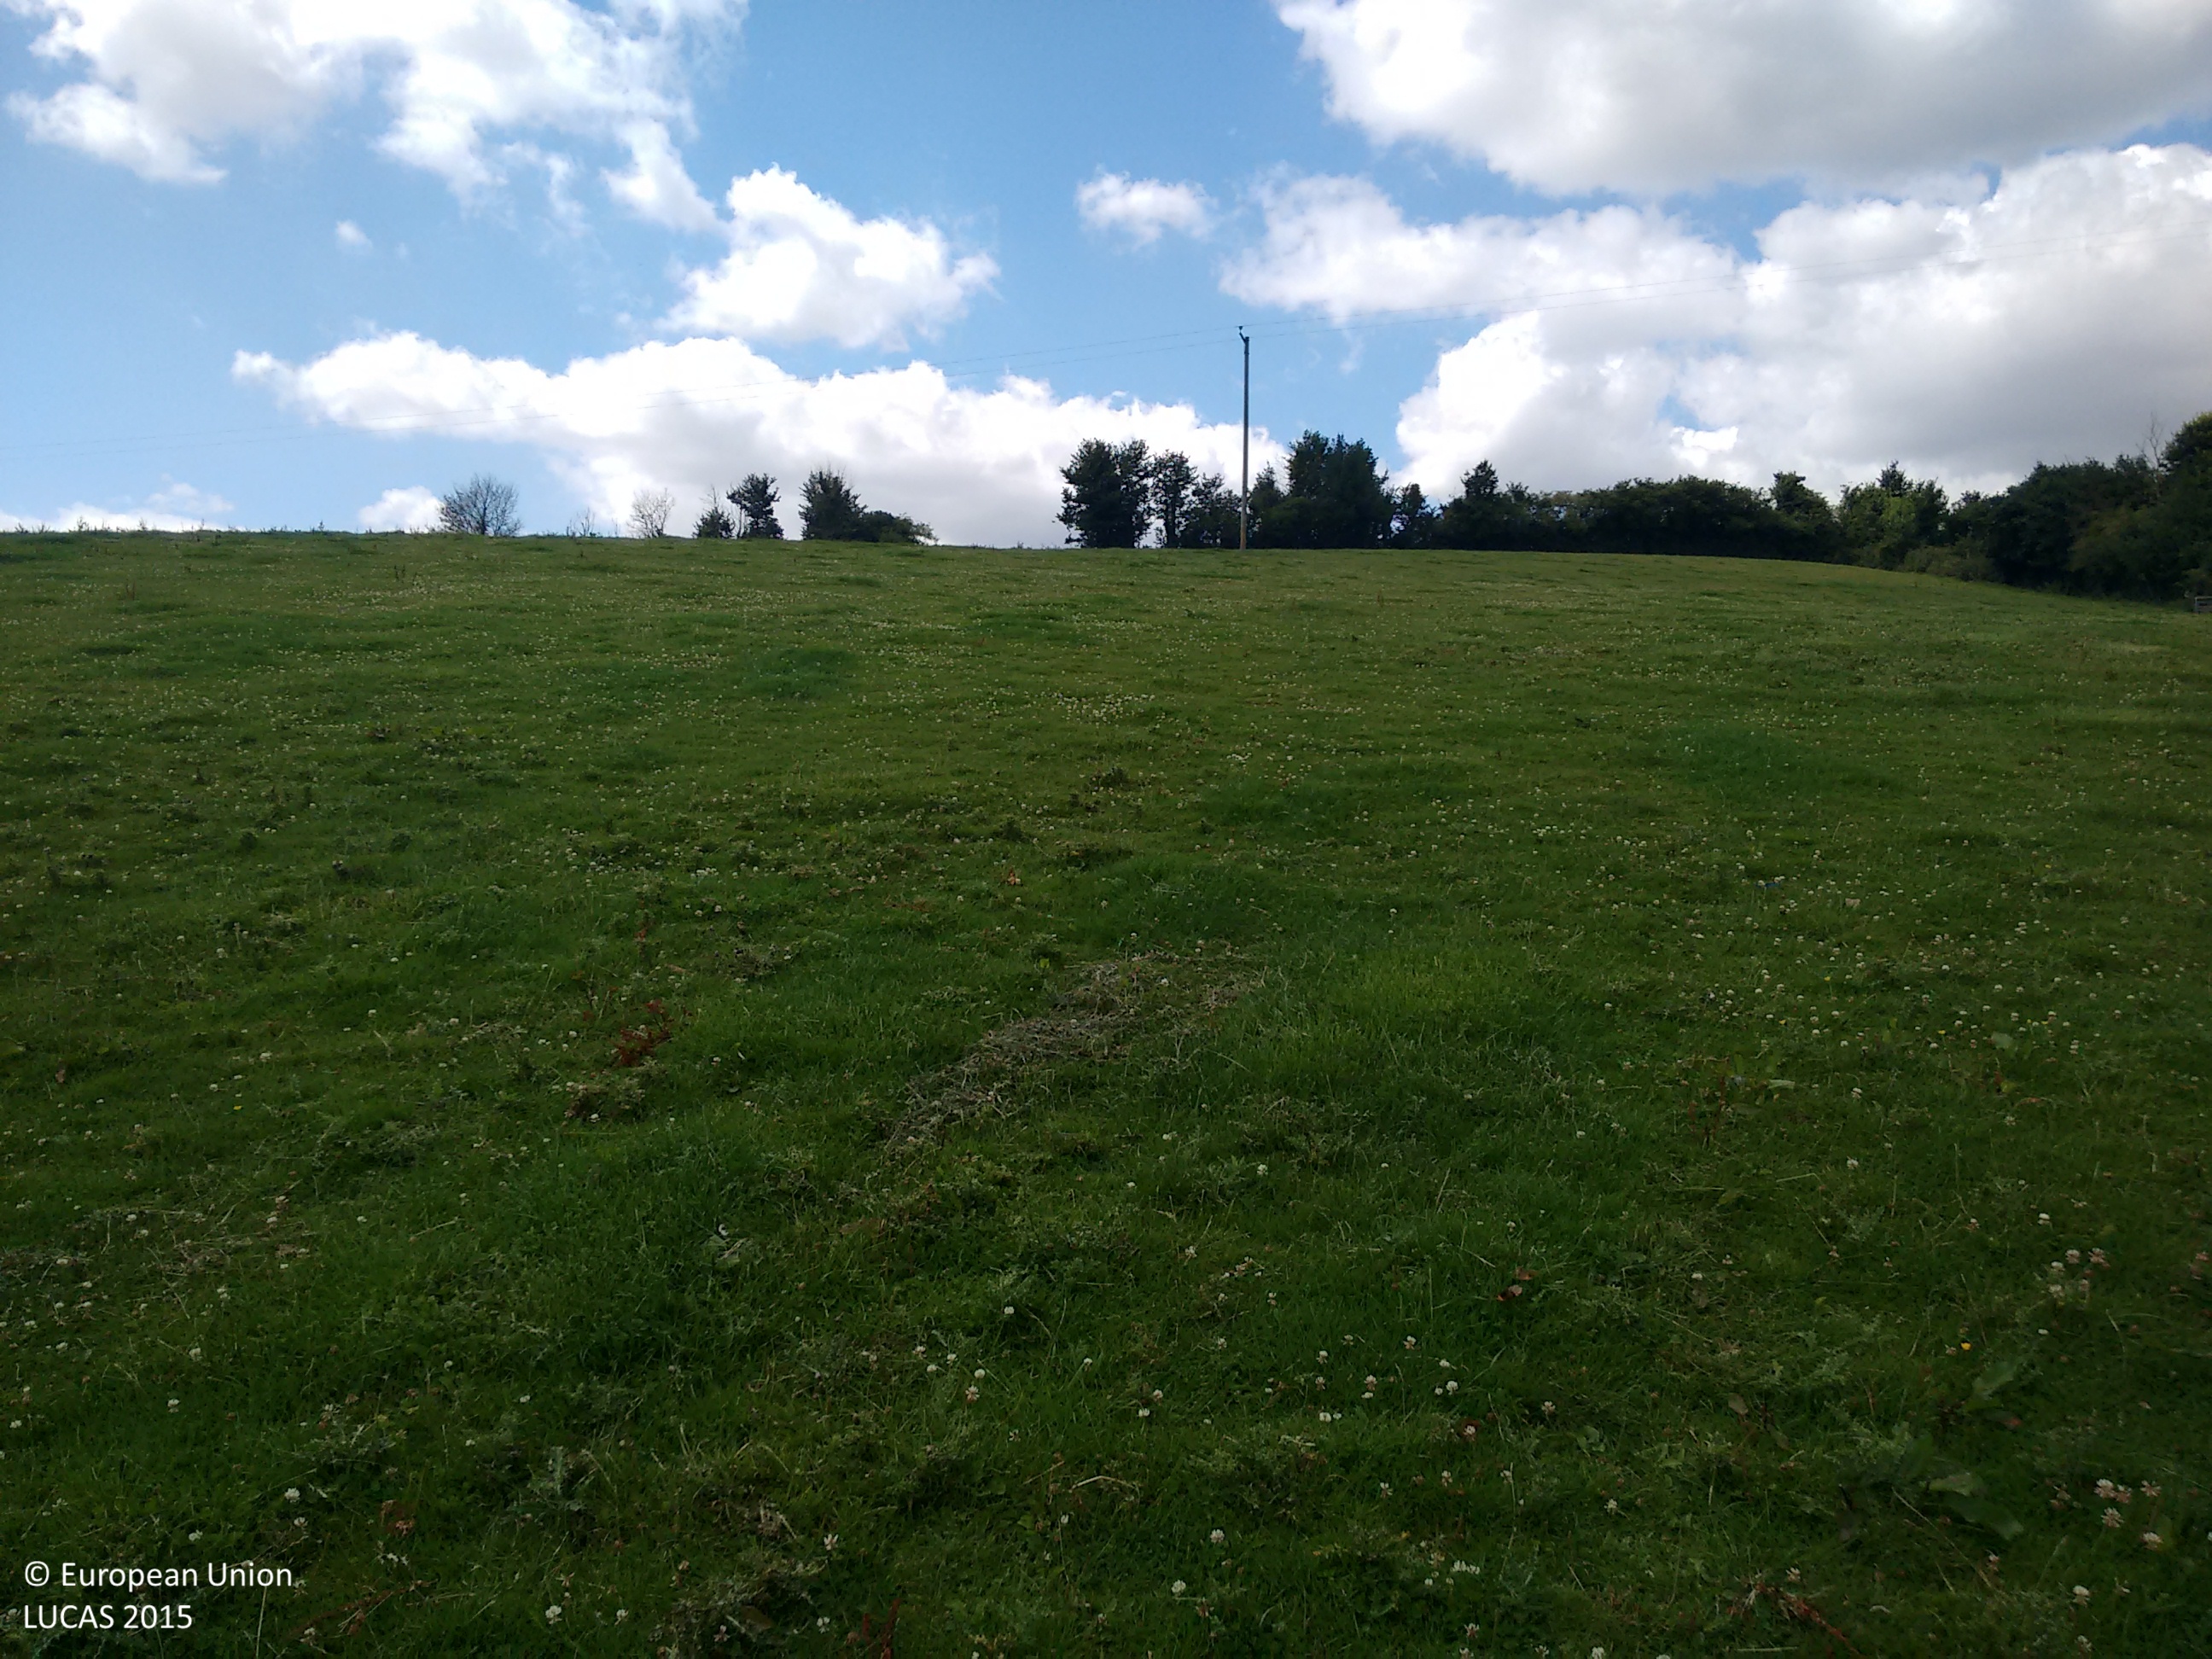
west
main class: Grassland
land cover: Grassland without tree/shrub cover
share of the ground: > 75 %
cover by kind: herbaceous plants 100 %
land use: Agriculture (excluding fallow land and kitchen gardens)
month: July
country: GB
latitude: 50.8243
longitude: -3.4414
